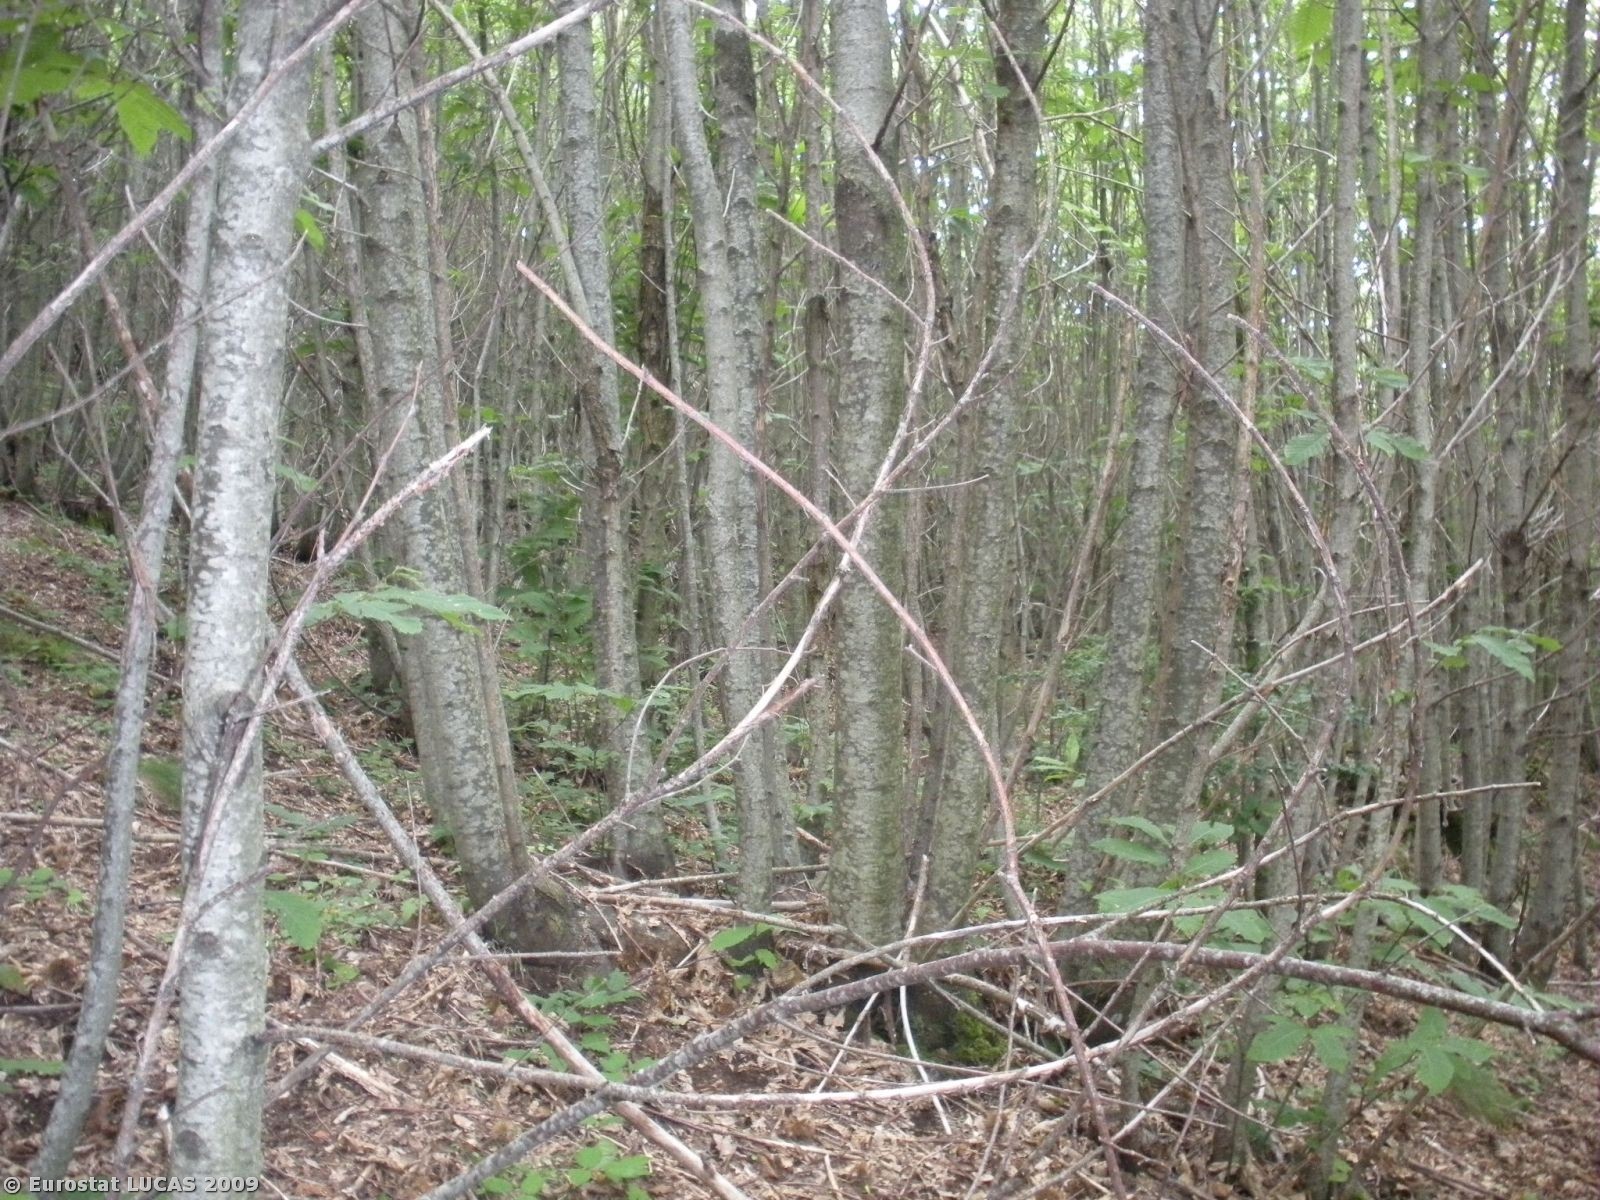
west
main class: Woodland
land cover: Broadleaved woodland
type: mesophytic deciduous forest
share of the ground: > 75 %
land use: Agriculture (excluding fallow land and kitchen gardens)
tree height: > 5 m
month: July
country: IT
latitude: 40.2451
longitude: 15.0675
